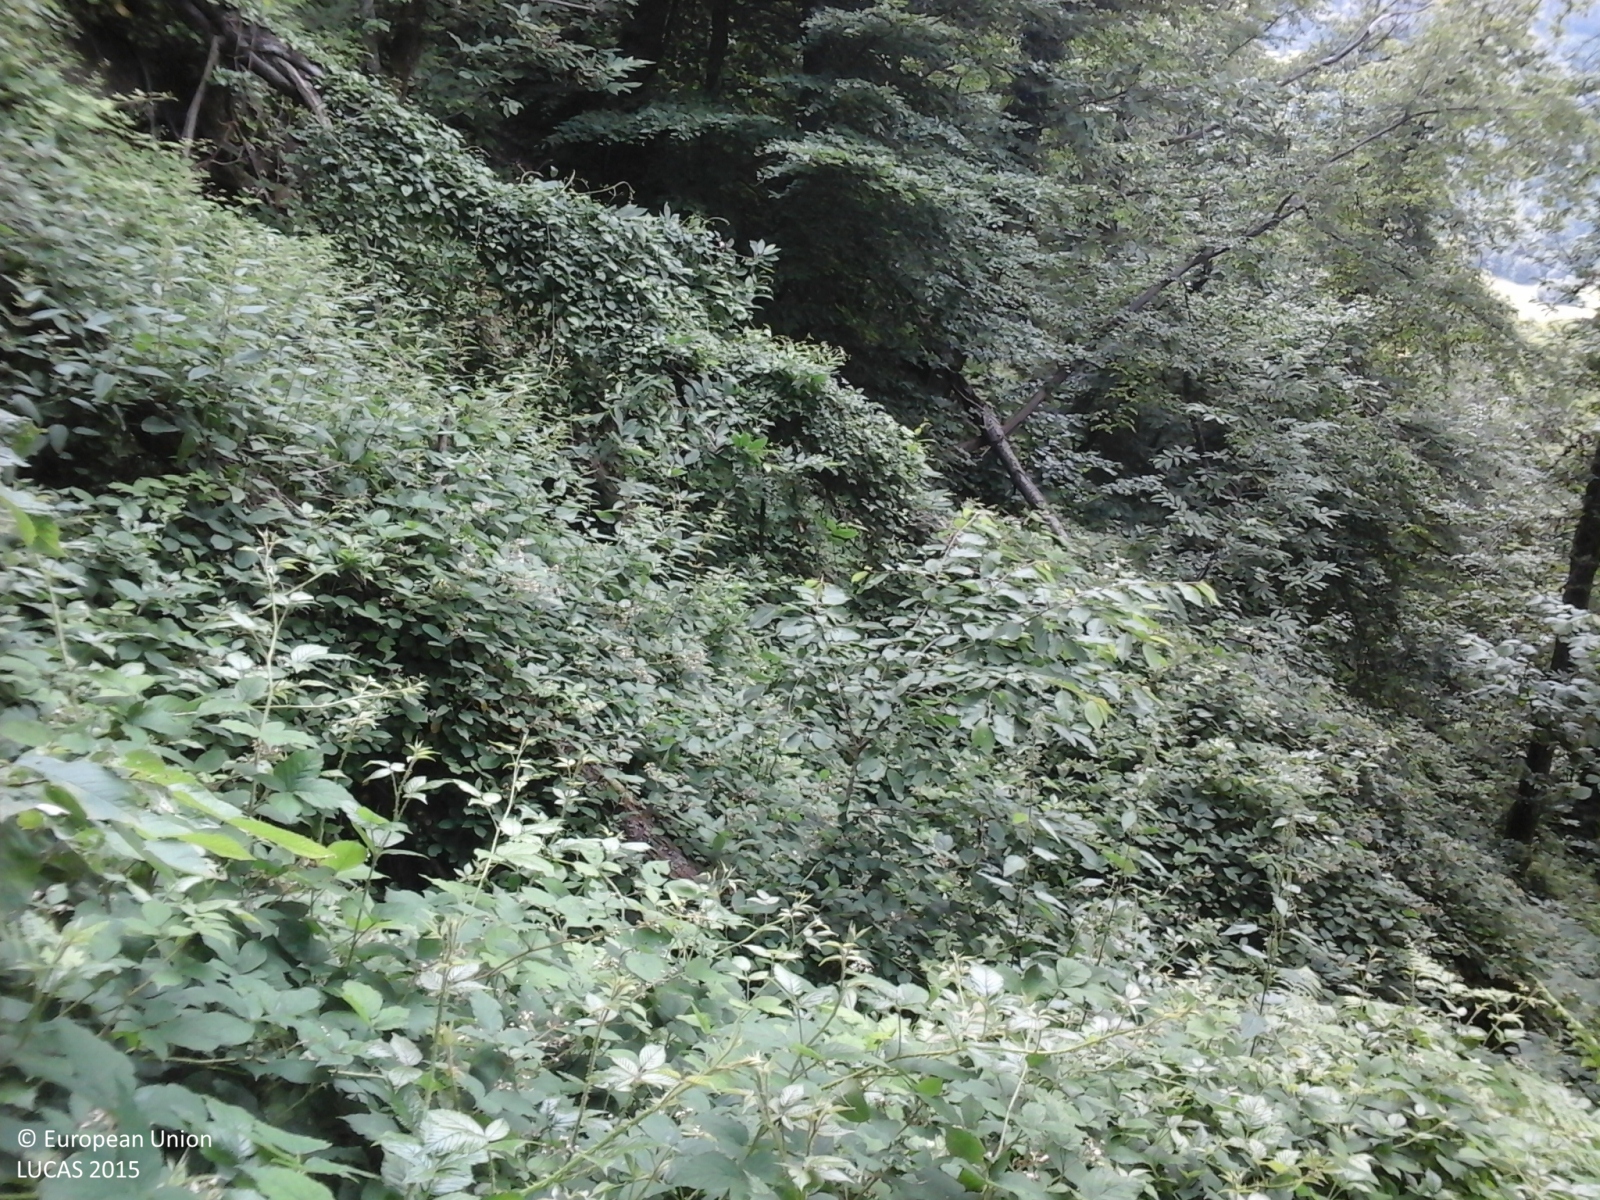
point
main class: Woodland
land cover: Broadleaved woodland
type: thermophilous deciduous forest
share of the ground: > 75 %
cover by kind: broadleaved forest trees 100 %
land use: Forestry
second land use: Other primary production
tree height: > 5 m
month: June
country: IT
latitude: 42.8334
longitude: 13.3546
